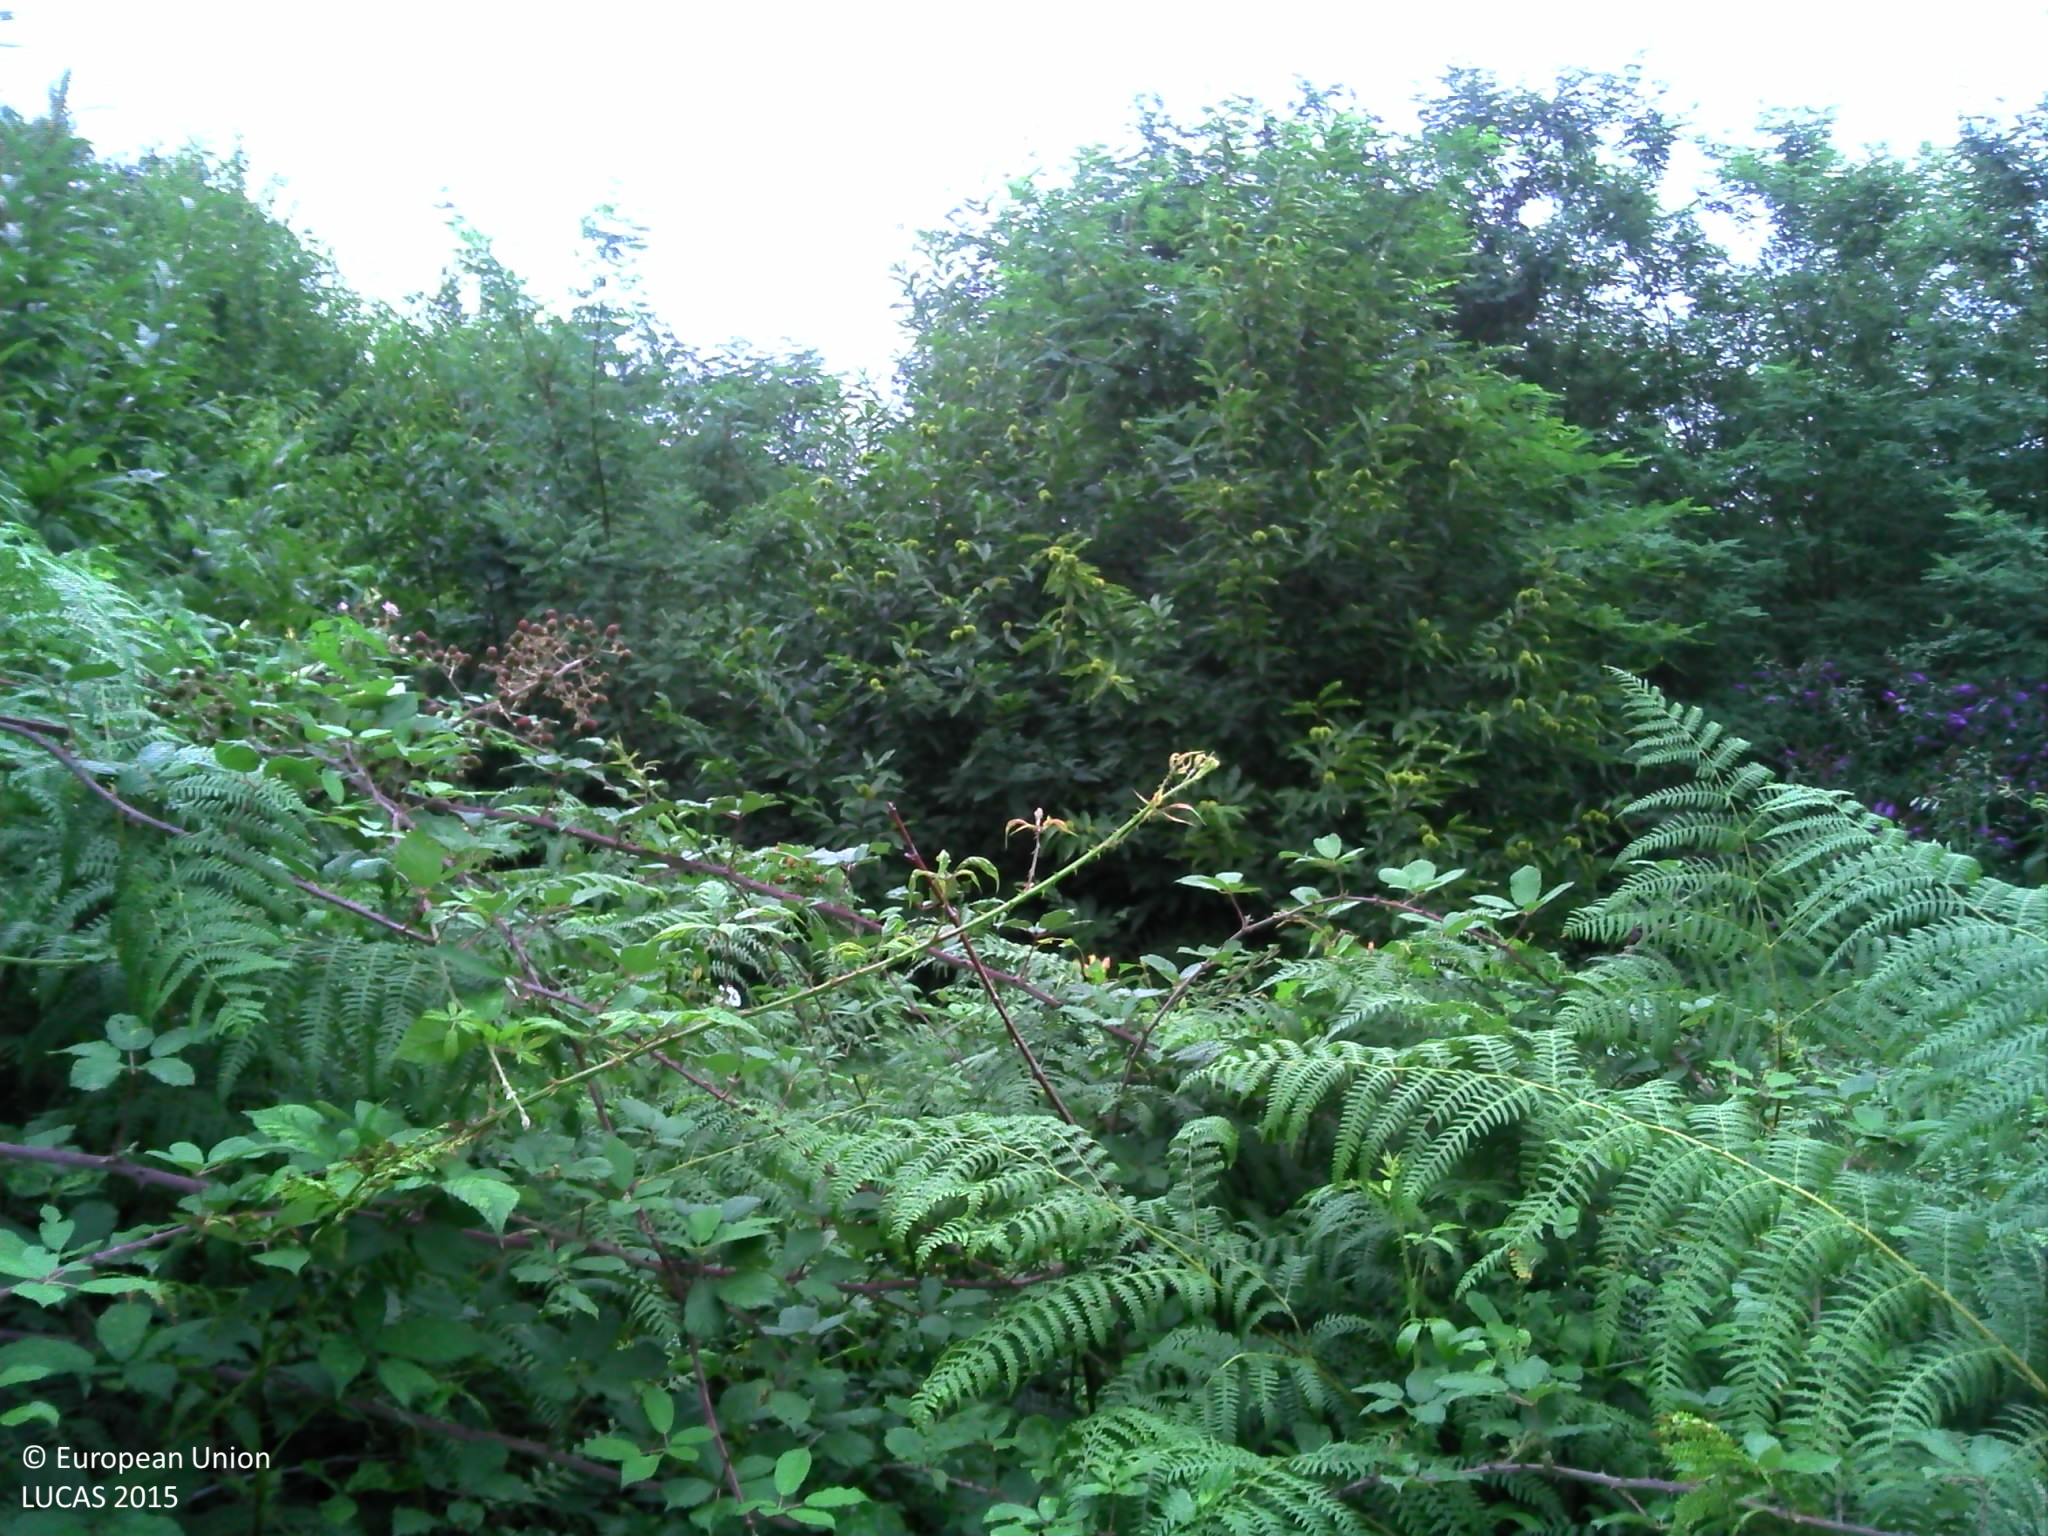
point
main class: Shrubland
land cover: Shrubland with sparse tree cover
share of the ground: > 75 %
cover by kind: shrubs 80 %, herbaceous plants 15 %, broadleaved forest trees 5 %
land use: Semi-natural and natural areas not in use
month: August
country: FR
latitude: 43.1731
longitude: -1.2446
